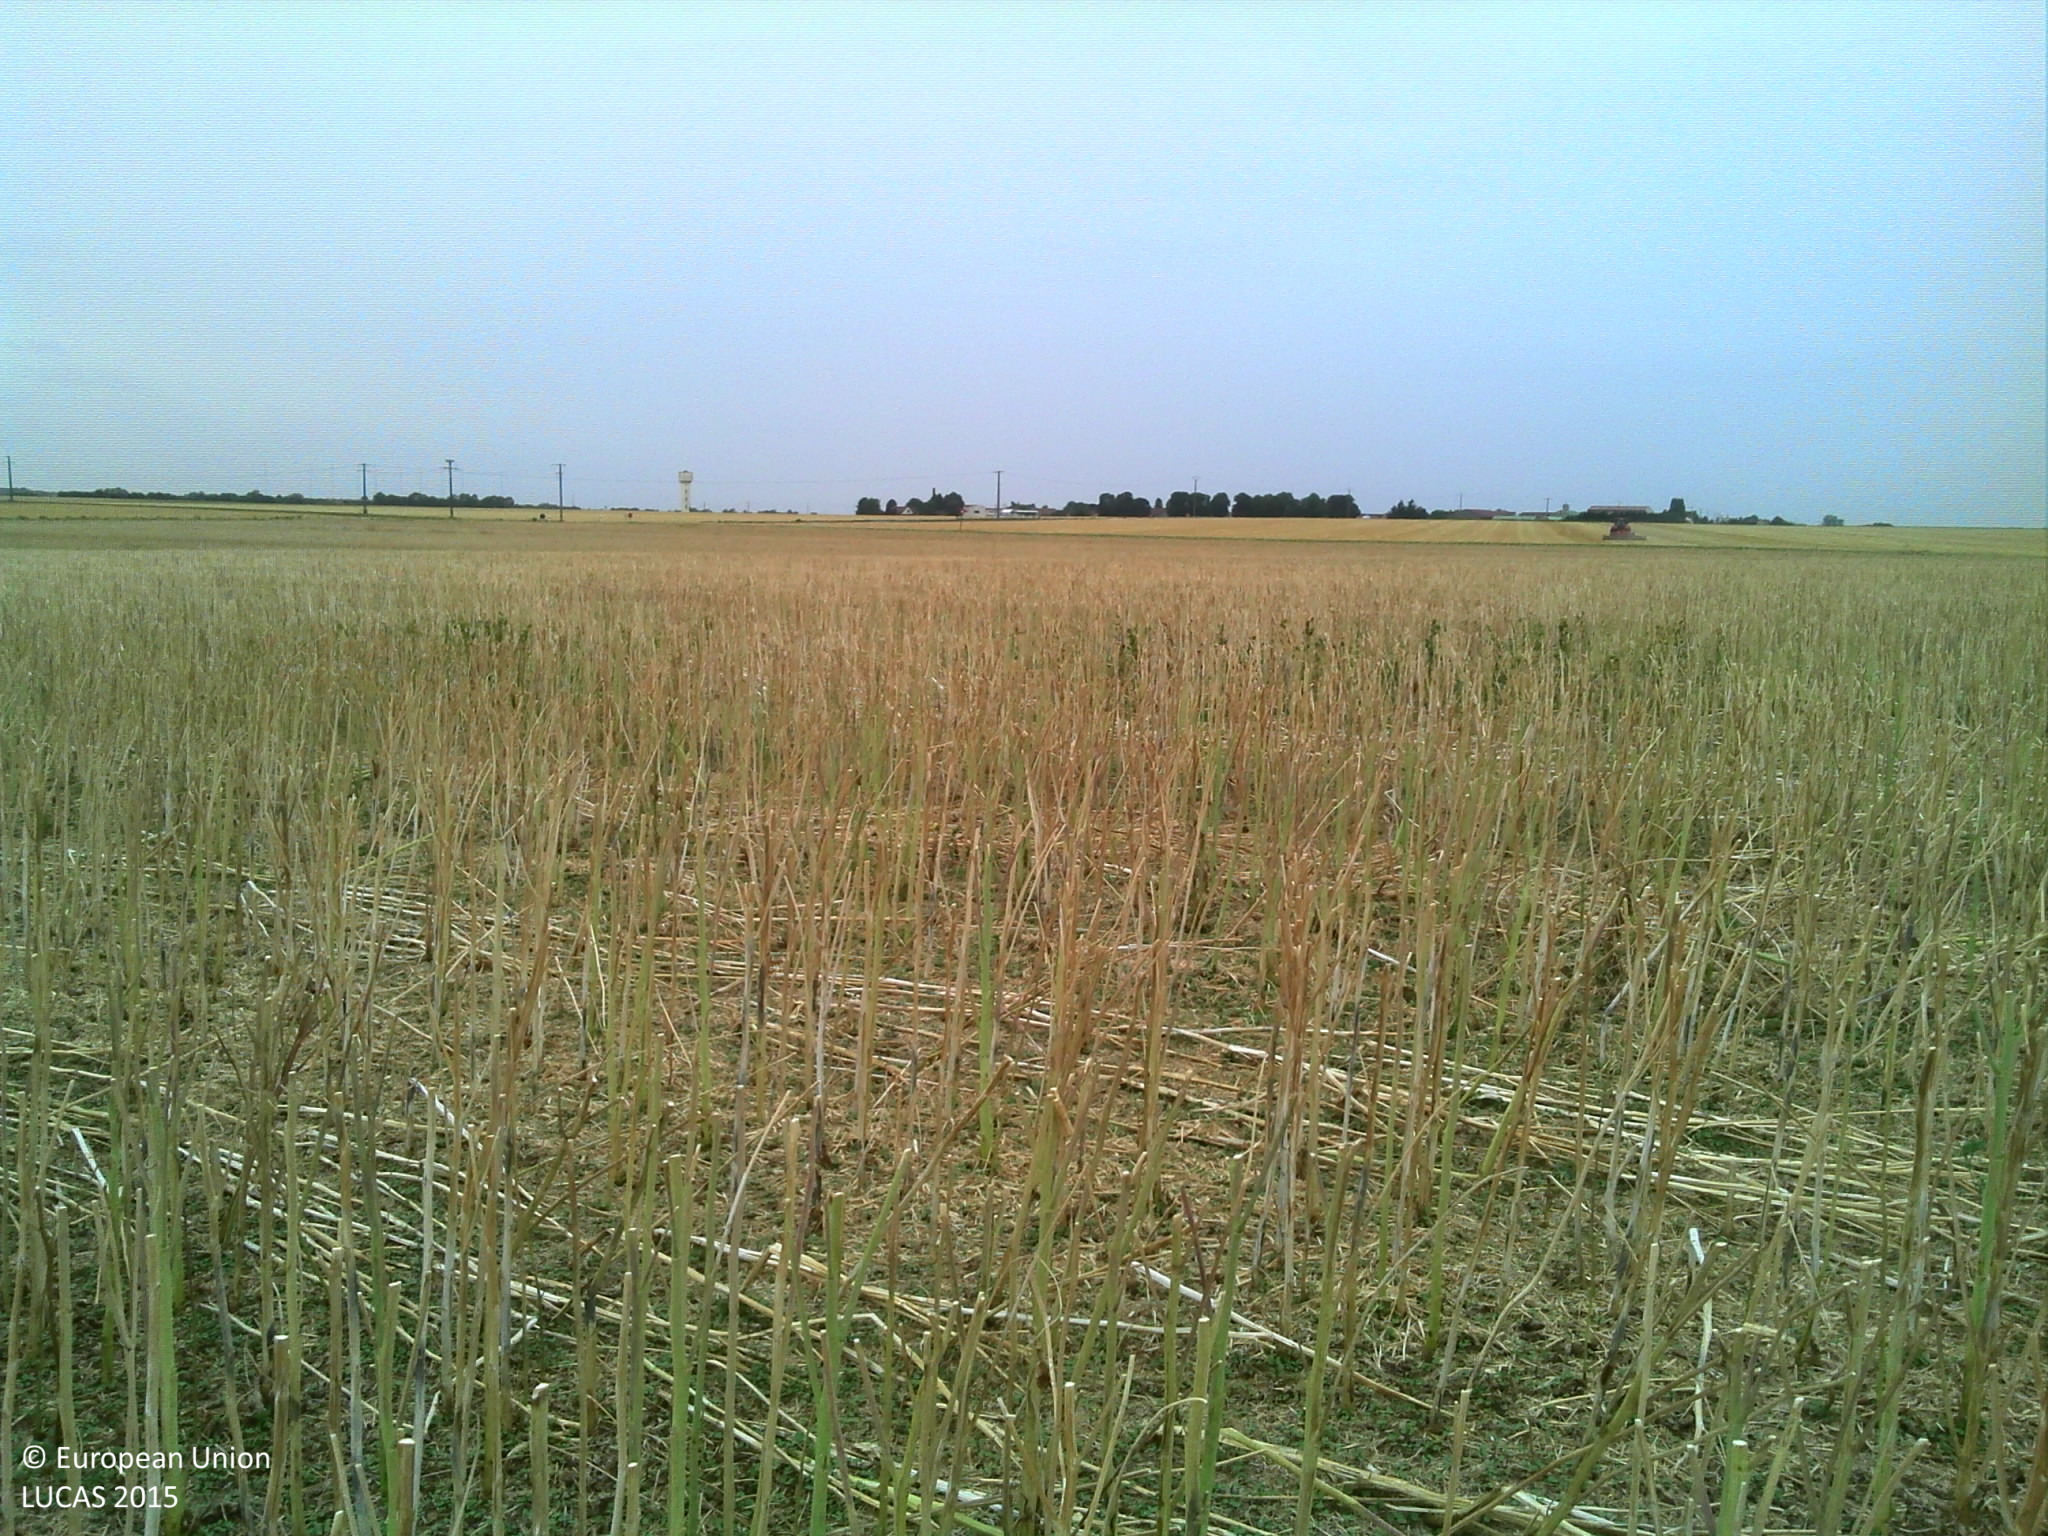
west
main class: Cropland
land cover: Rape and turnip rape
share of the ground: > 75 %
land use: Agriculture (excluding fallow land and kitchen gardens)
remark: Harvested field
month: July
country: FR
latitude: 48.5962
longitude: 2.7089
